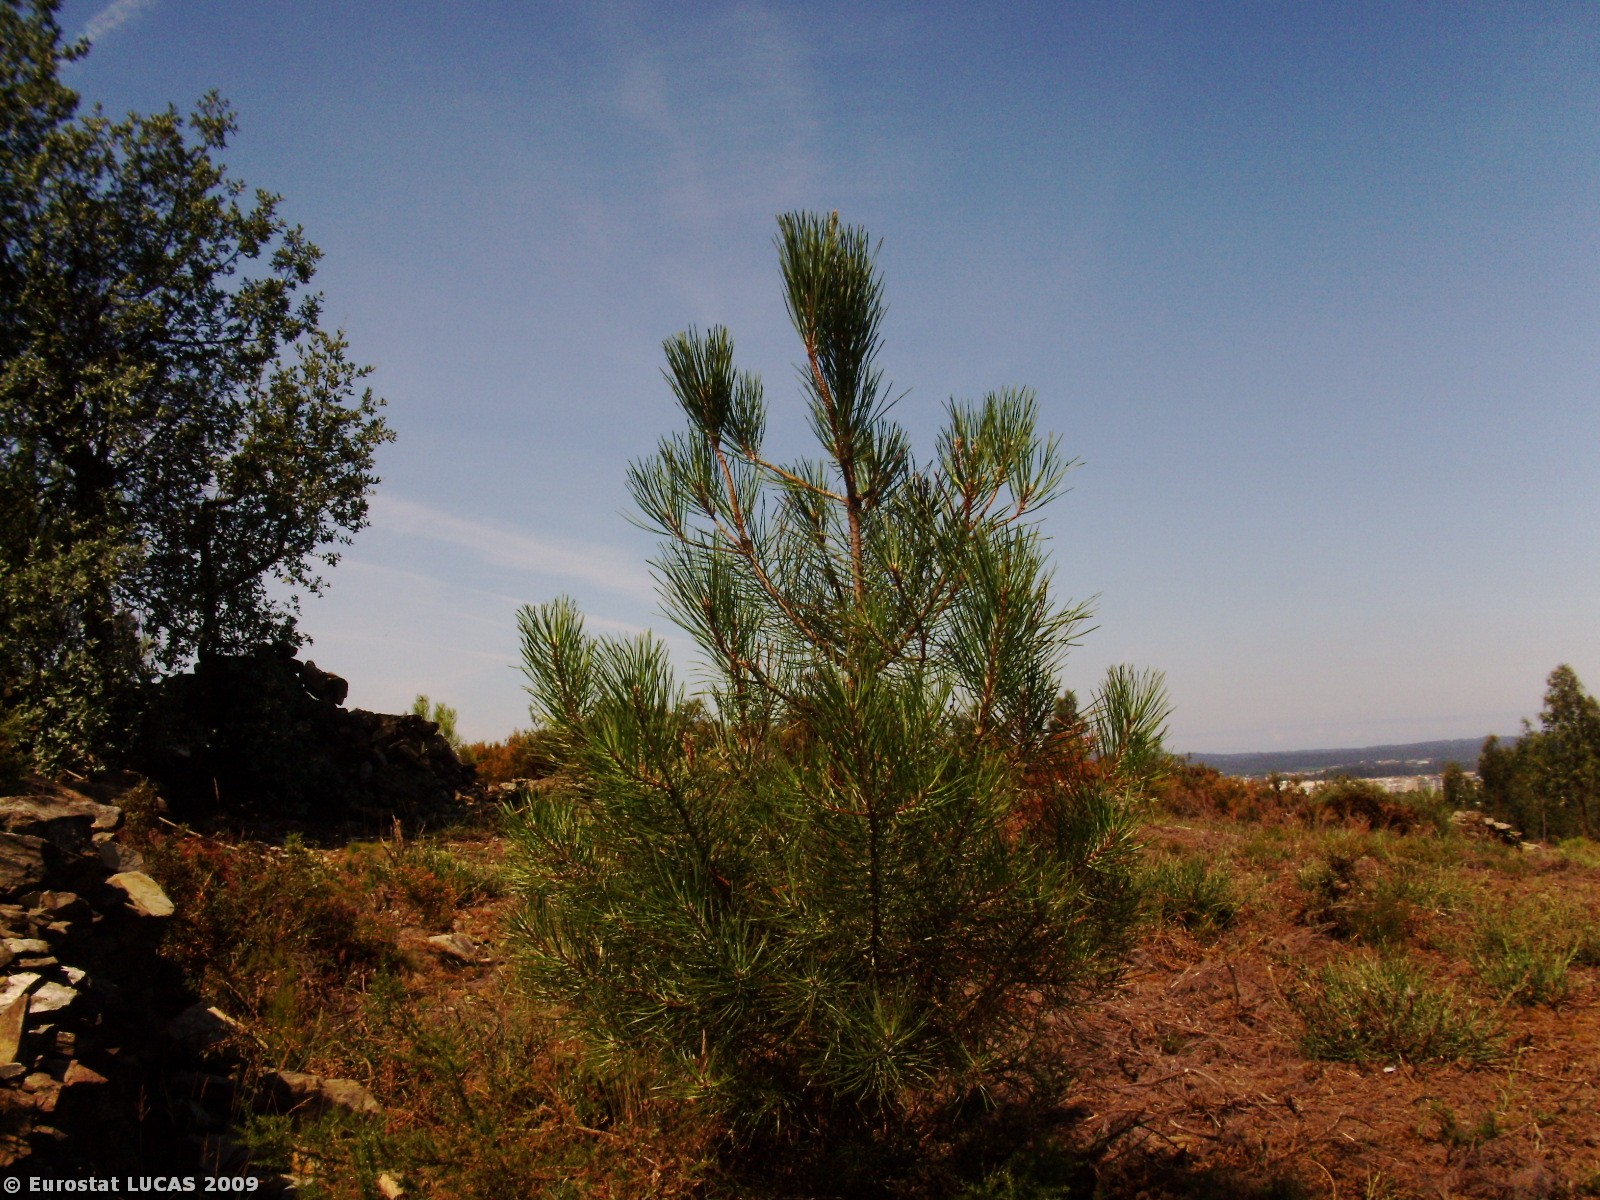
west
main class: Shrubland
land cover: Shrubland without tree cover
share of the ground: > 75 %
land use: Forestry
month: July
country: PT
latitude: 41.3351
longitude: -8.5190
